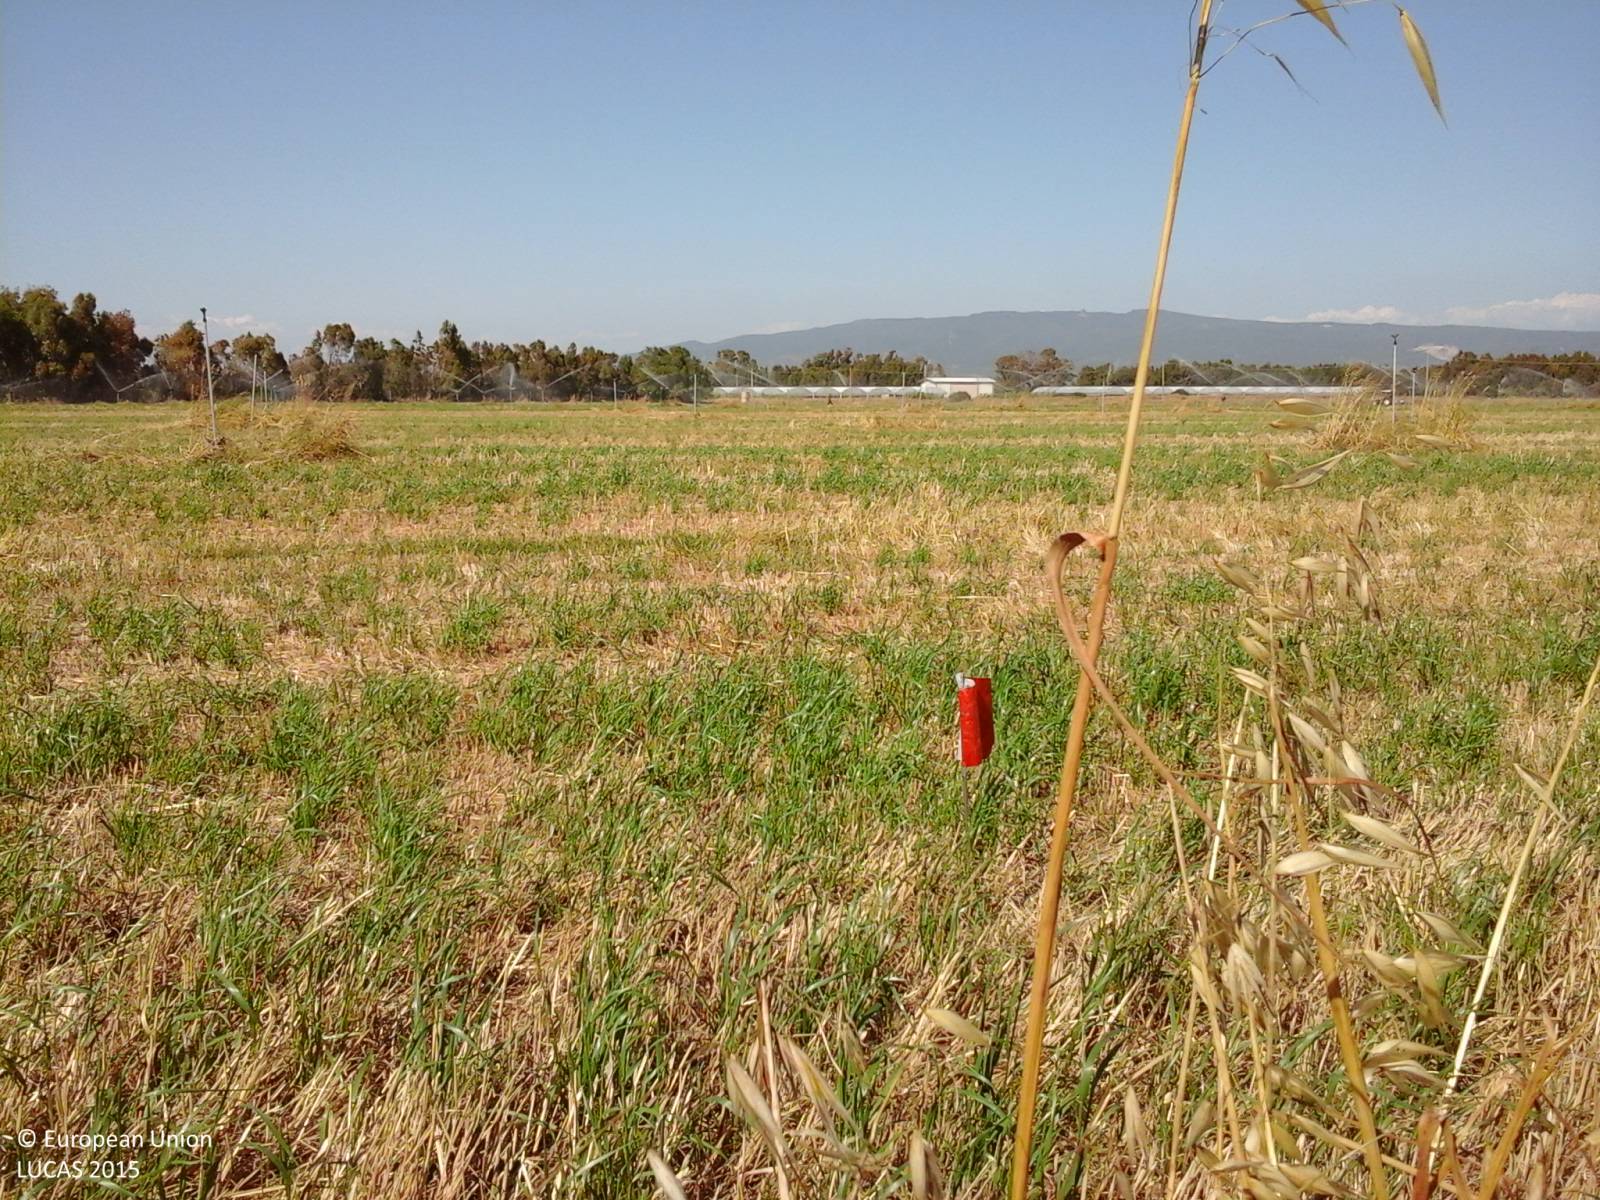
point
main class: Cropland
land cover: Temporary grasslands
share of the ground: > 75 %
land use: Agriculture (excluding fallow land and kitchen gardens)
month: May
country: IT
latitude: 39.7140
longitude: 8.5966
